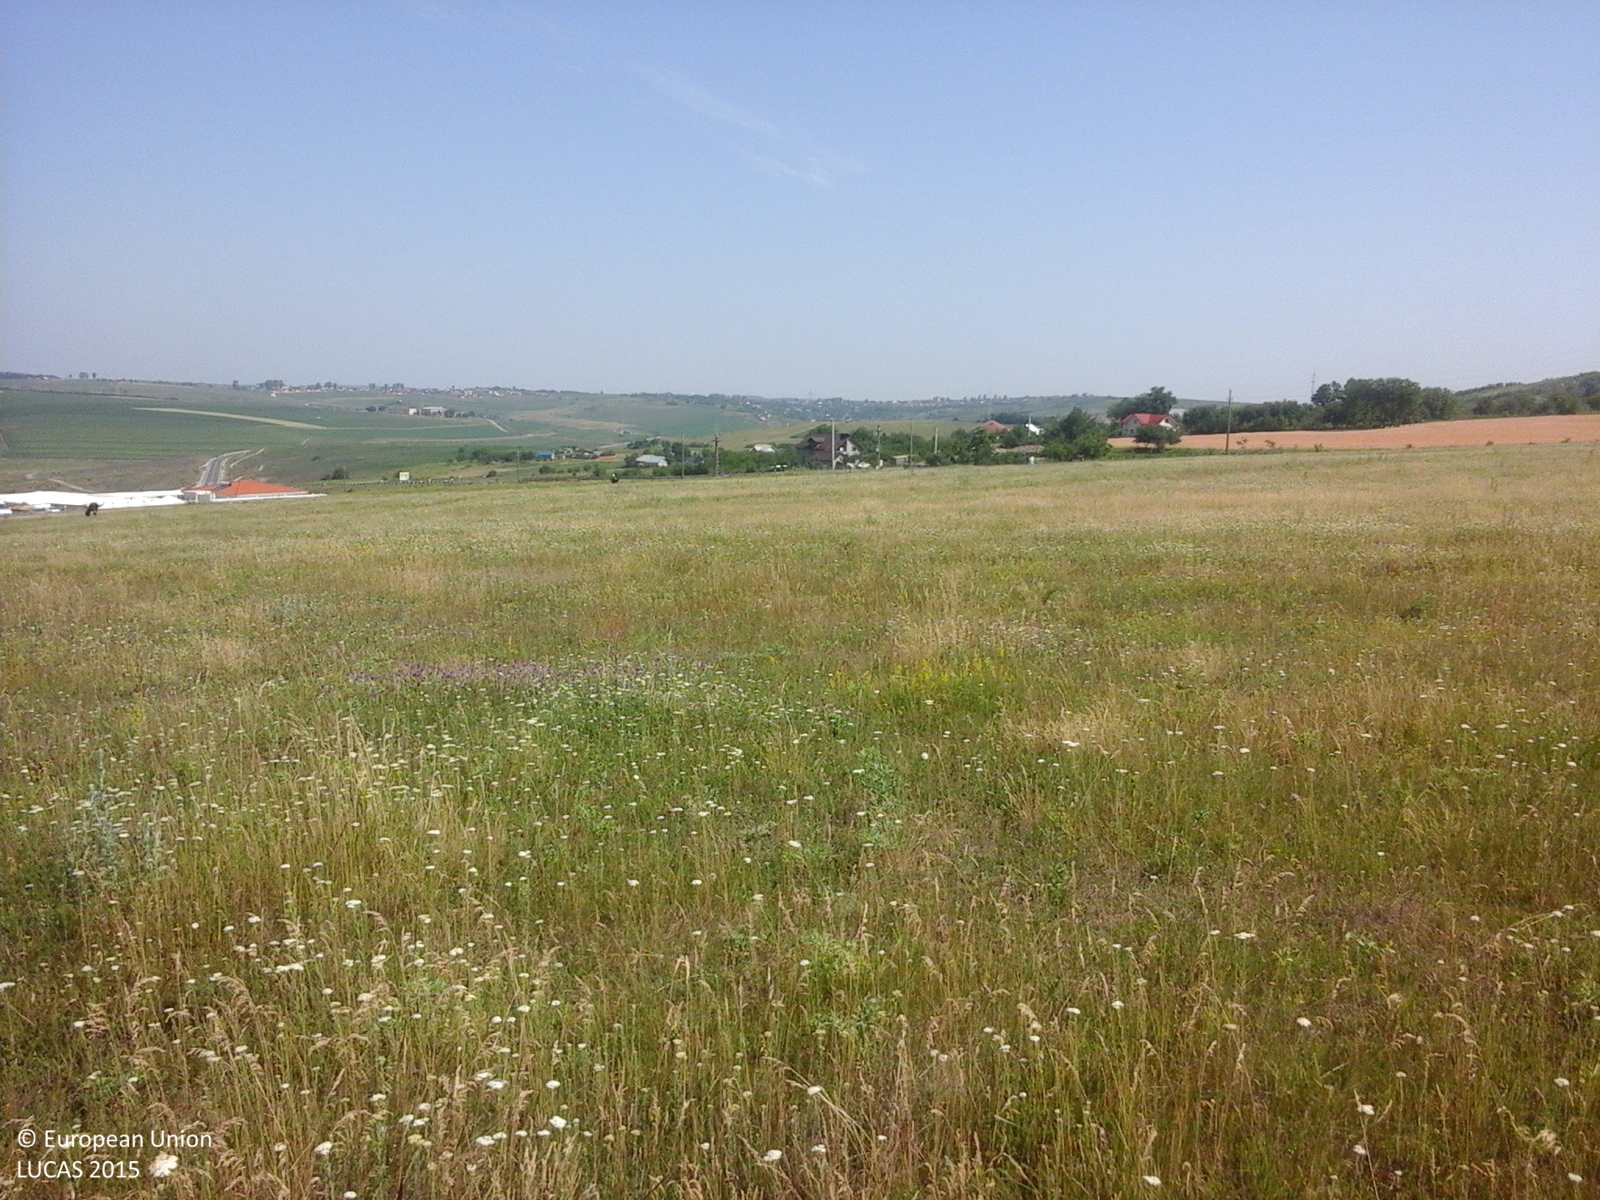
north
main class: Grassland
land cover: Grassland without tree/shrub cover
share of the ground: > 75 %
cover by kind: herbaceous plants 100 %
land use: Agriculture (excluding fallow land and kitchen gardens)
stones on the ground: < 10 %
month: June
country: RO
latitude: 47.1000
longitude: 27.5211
